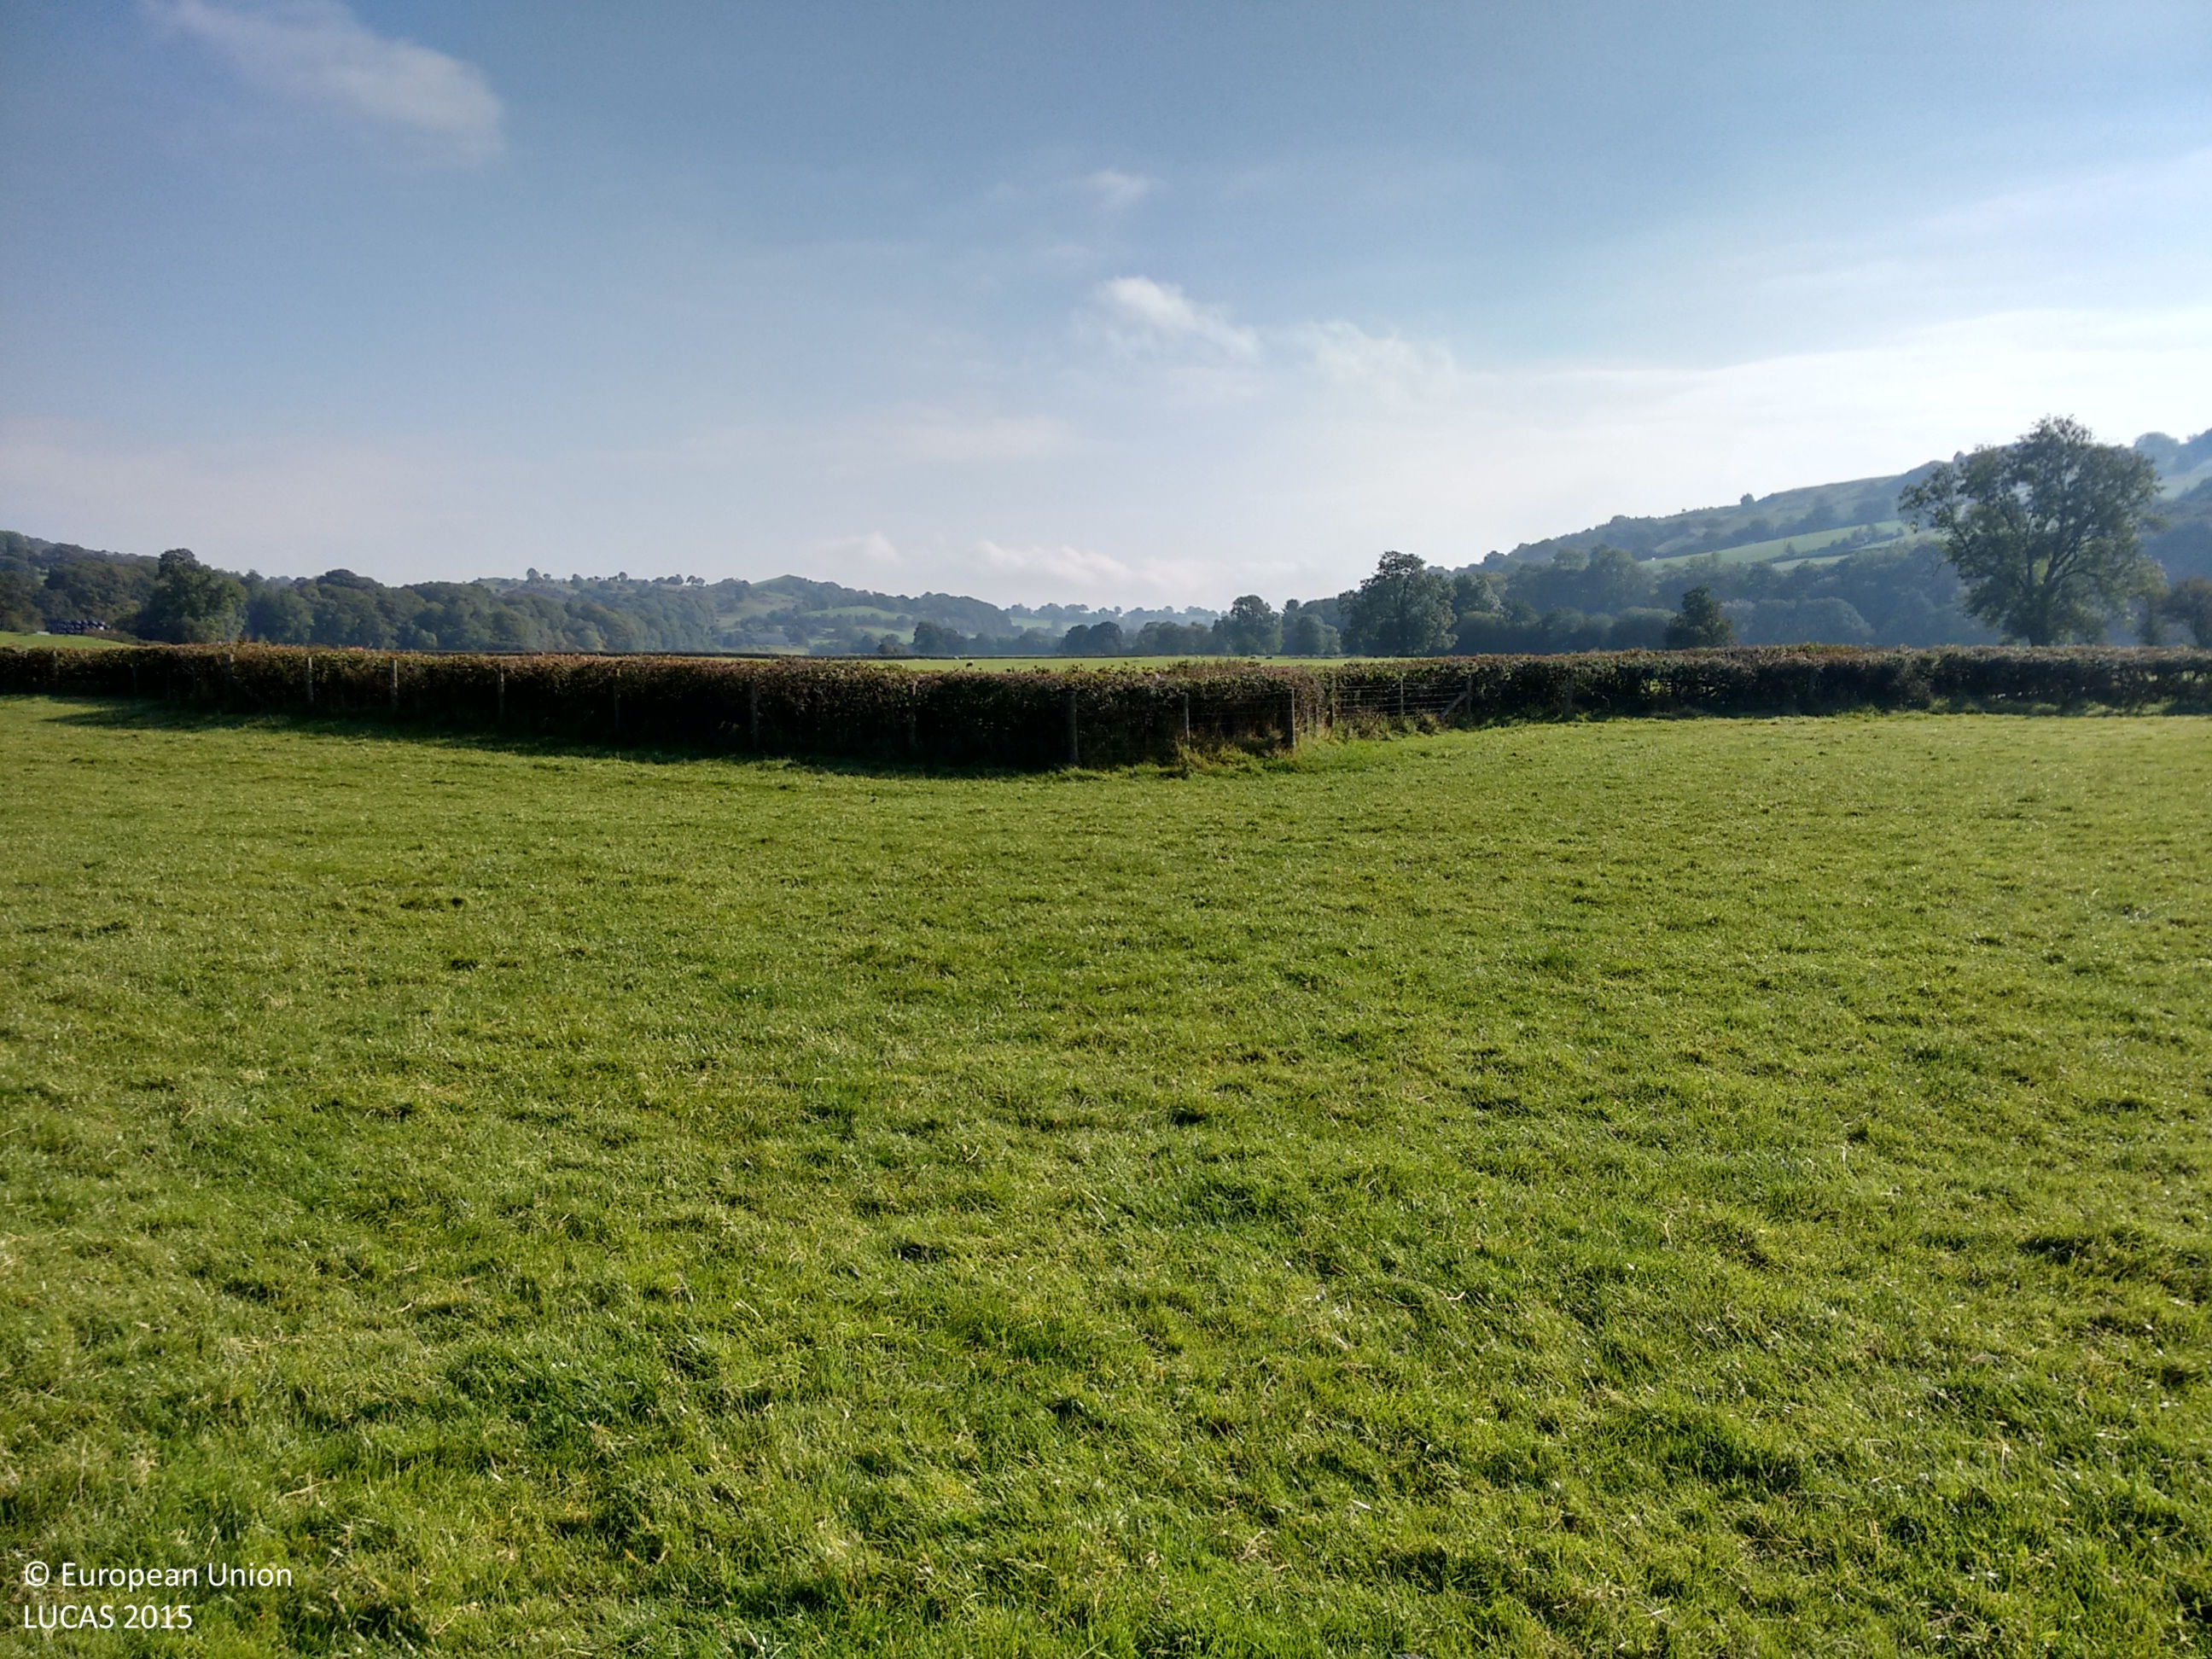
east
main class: Grassland
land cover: Grassland without tree/shrub cover
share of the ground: > 75 %
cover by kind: herbaceous plants 100 %
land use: Agriculture (excluding fallow land and kitchen gardens)
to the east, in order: Grassland without tree/shrub cover; Fences; Managed hedges; Grassland without tree/shrub cover
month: October
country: GB
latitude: 52.6878
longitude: -3.4120
